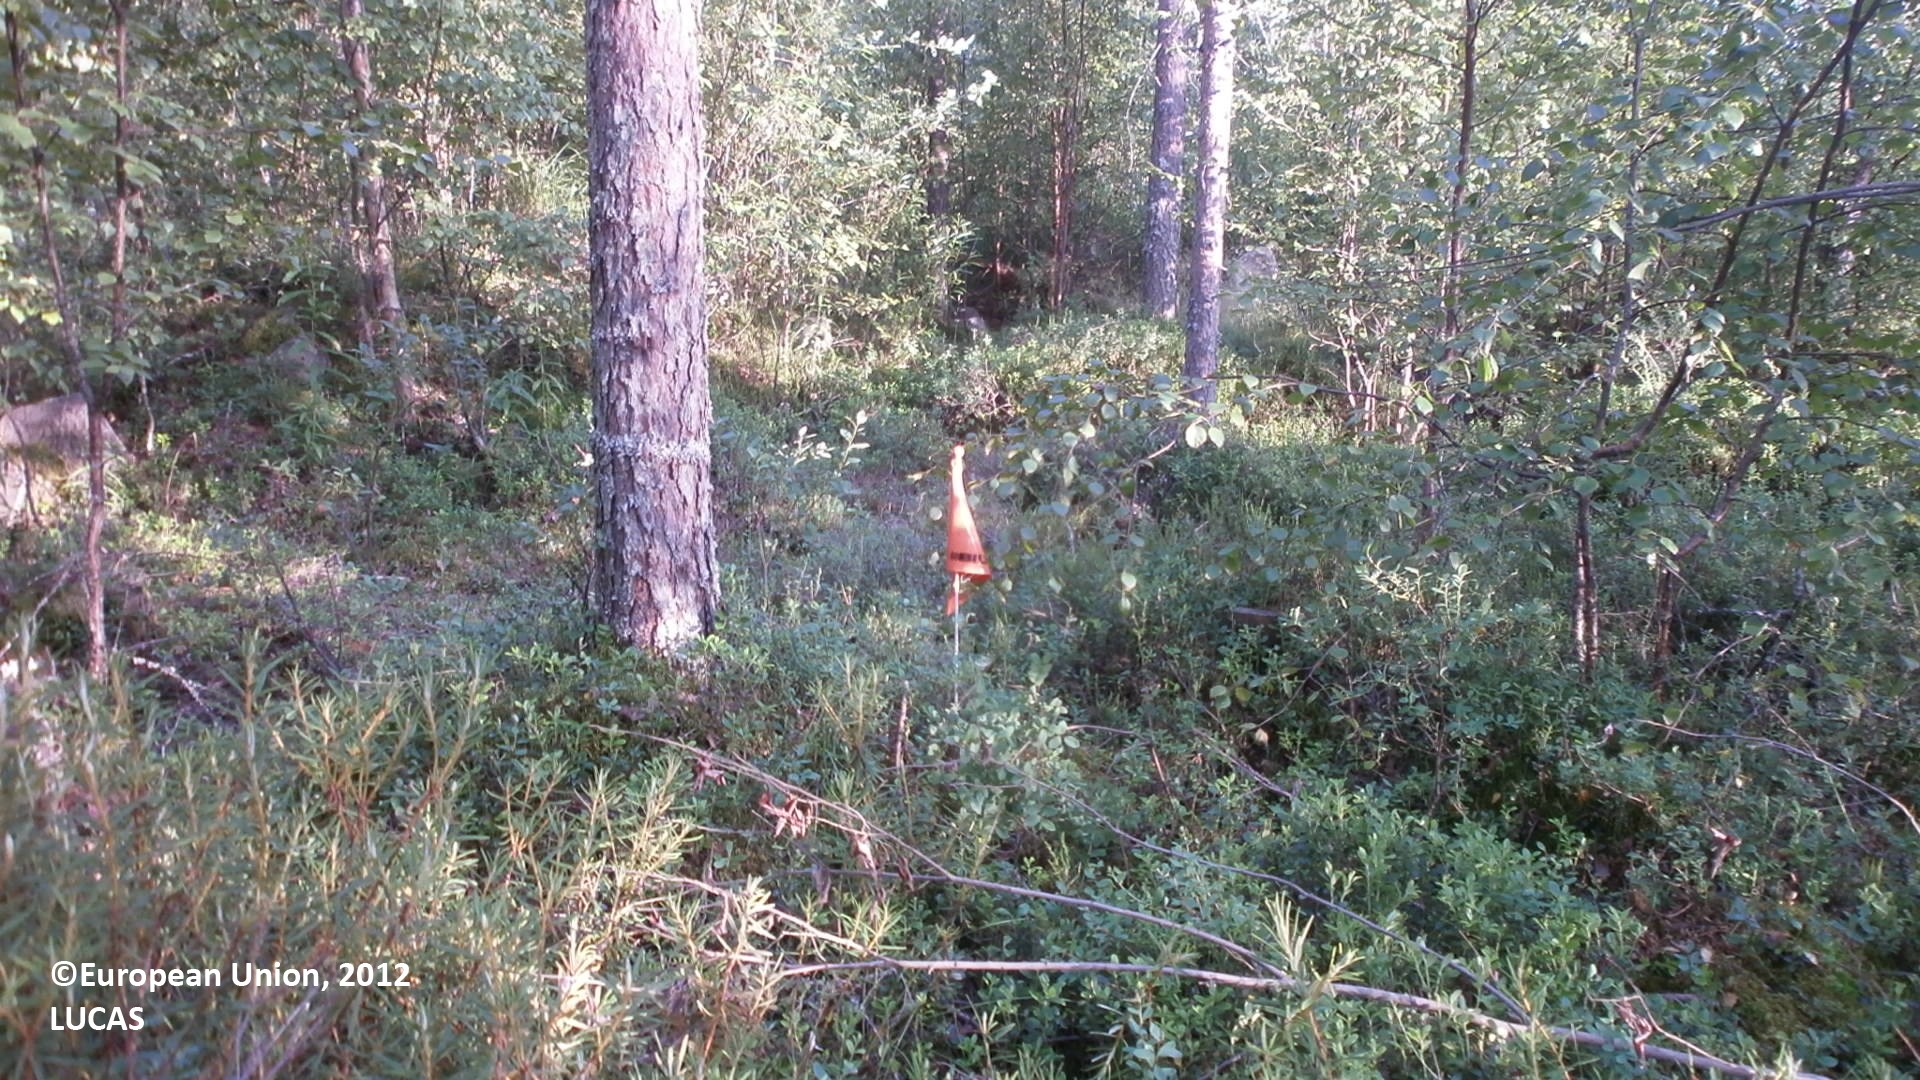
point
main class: Woodland
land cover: Pine dominated mixed woodland
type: boreal forest
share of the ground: > 75 %
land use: Forestry
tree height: > 5 m
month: July
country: FI
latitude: 64.0758
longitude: 24.3189
